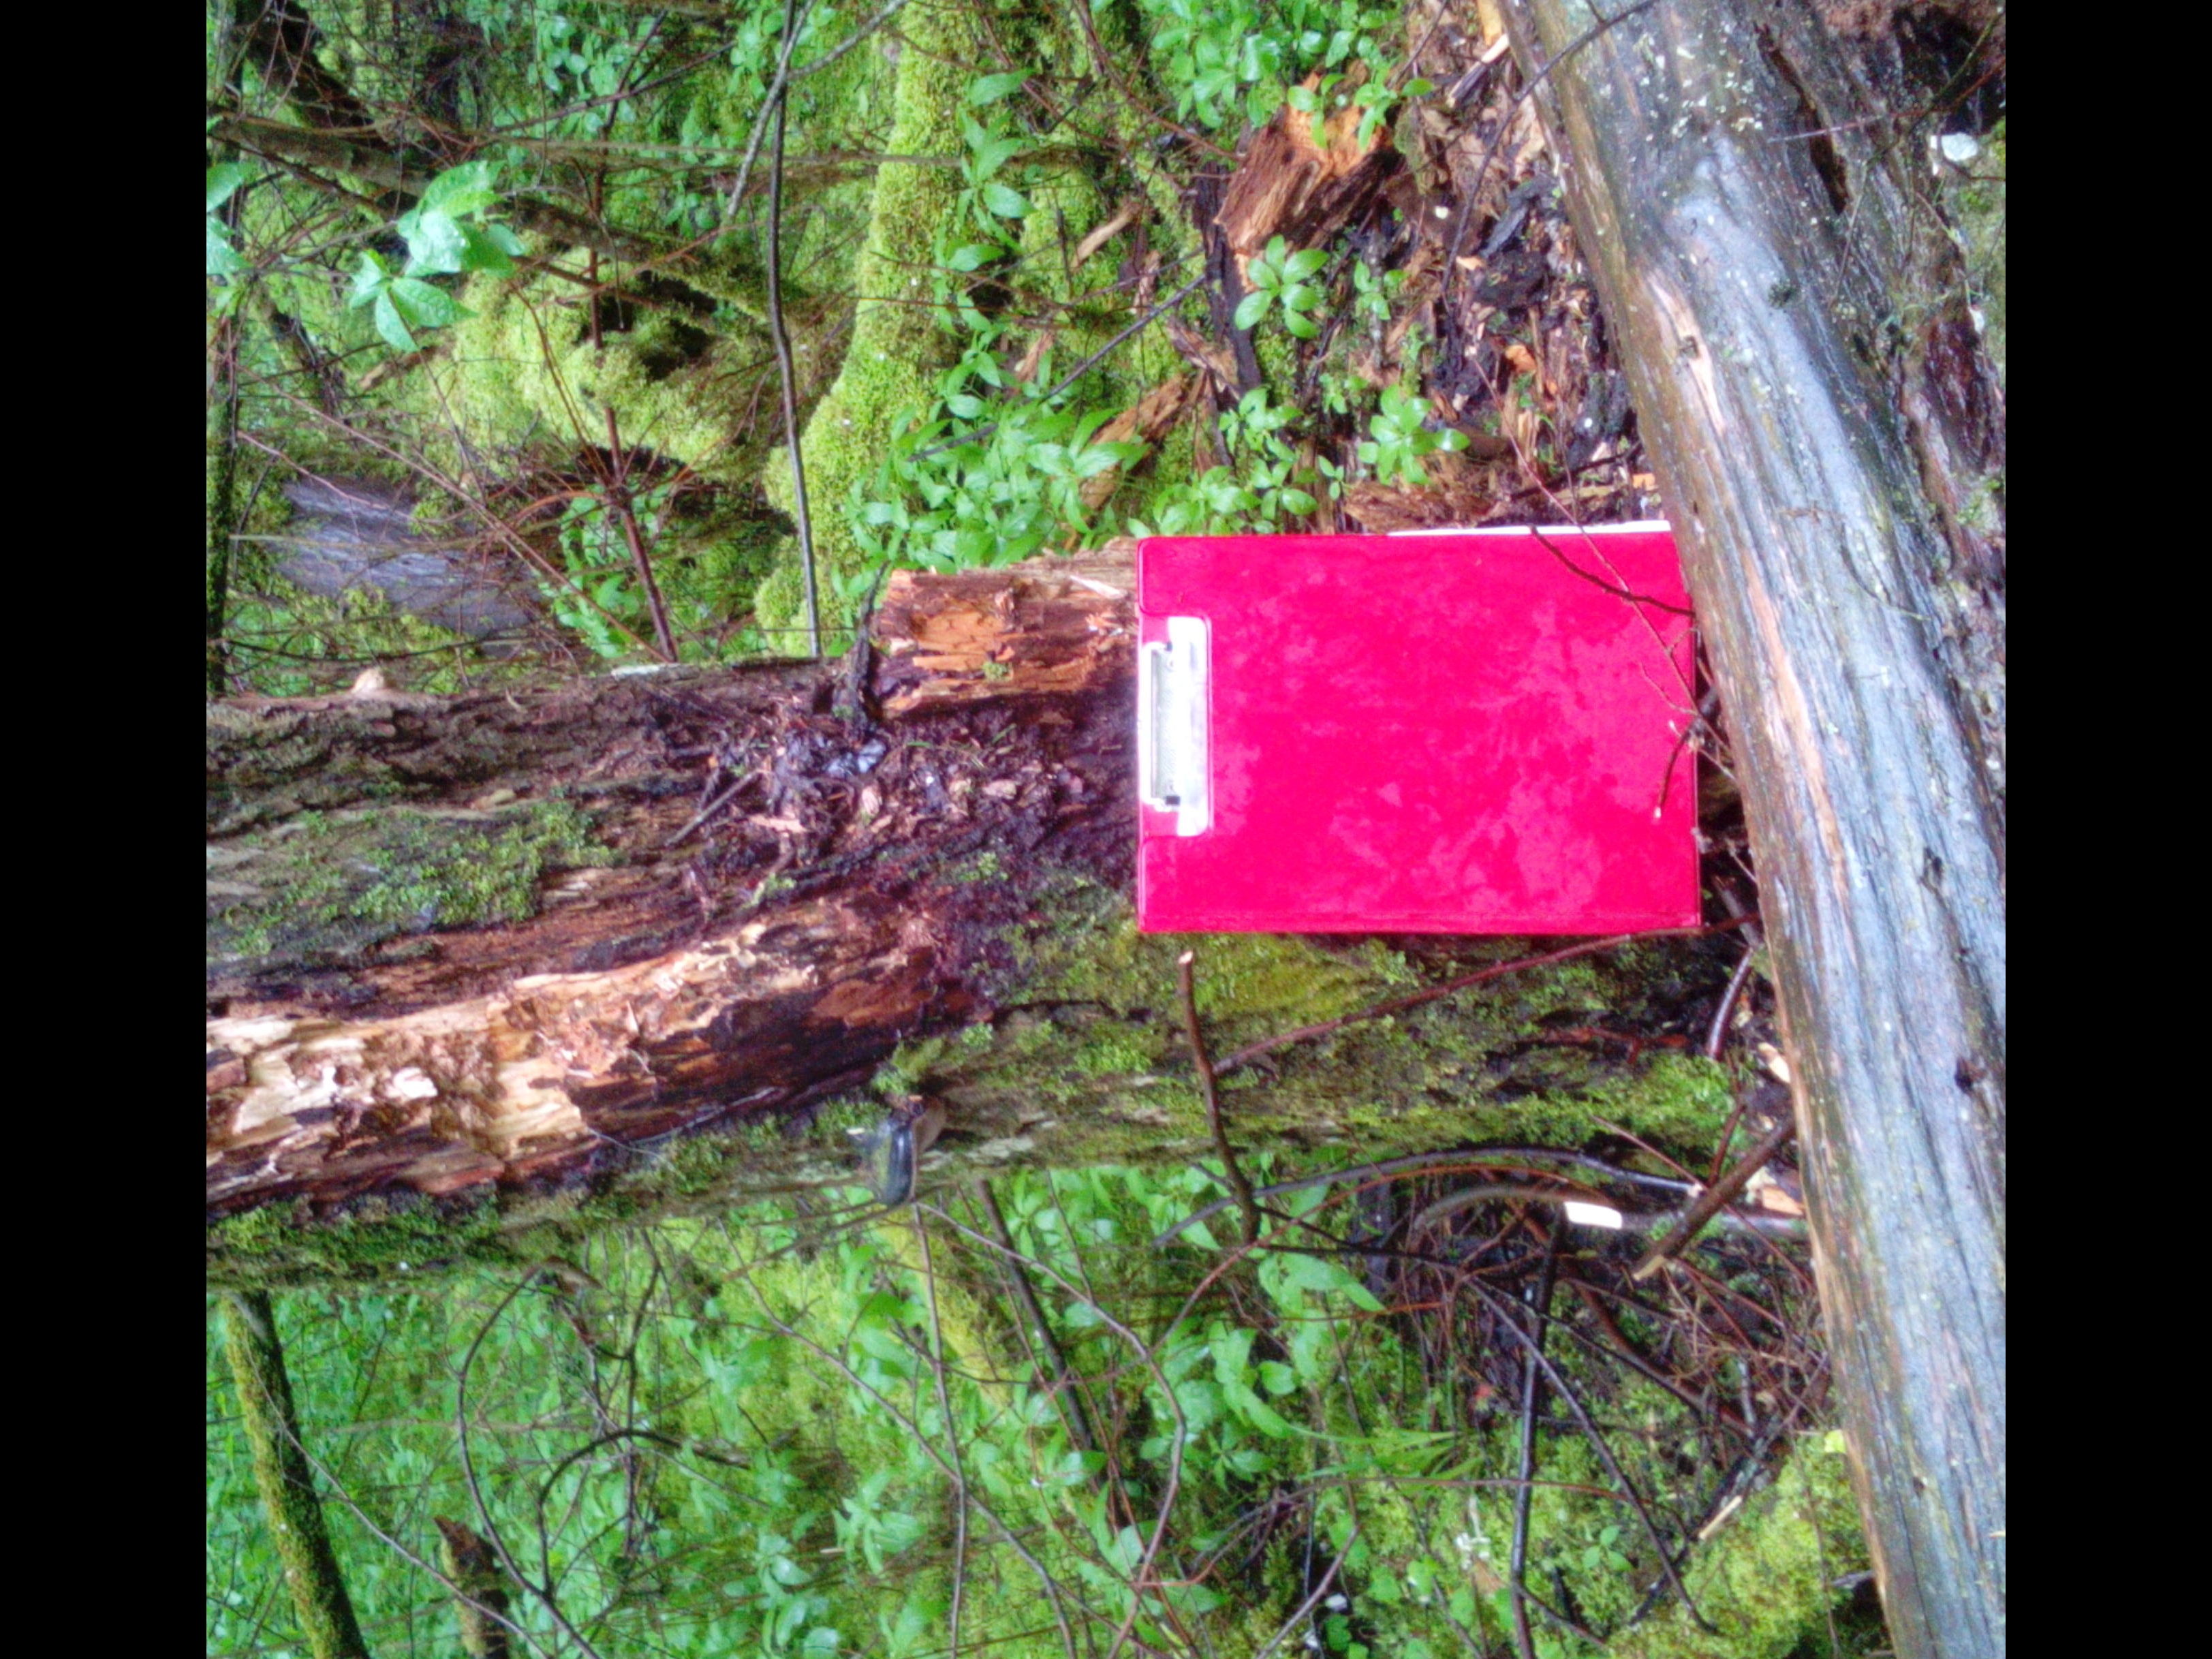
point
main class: Woodland
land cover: Broadleaved woodland
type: non-riverine alder, birch or aspen forest
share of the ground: > 75 %
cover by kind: broadleaved forest trees 80 %, coniferous forest trees 10 %, herbaceous plants 5 %, lichens and mosses 5 %
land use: Forestry
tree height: > 5 m
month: May
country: LV
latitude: 56.7468
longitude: 22.7993
